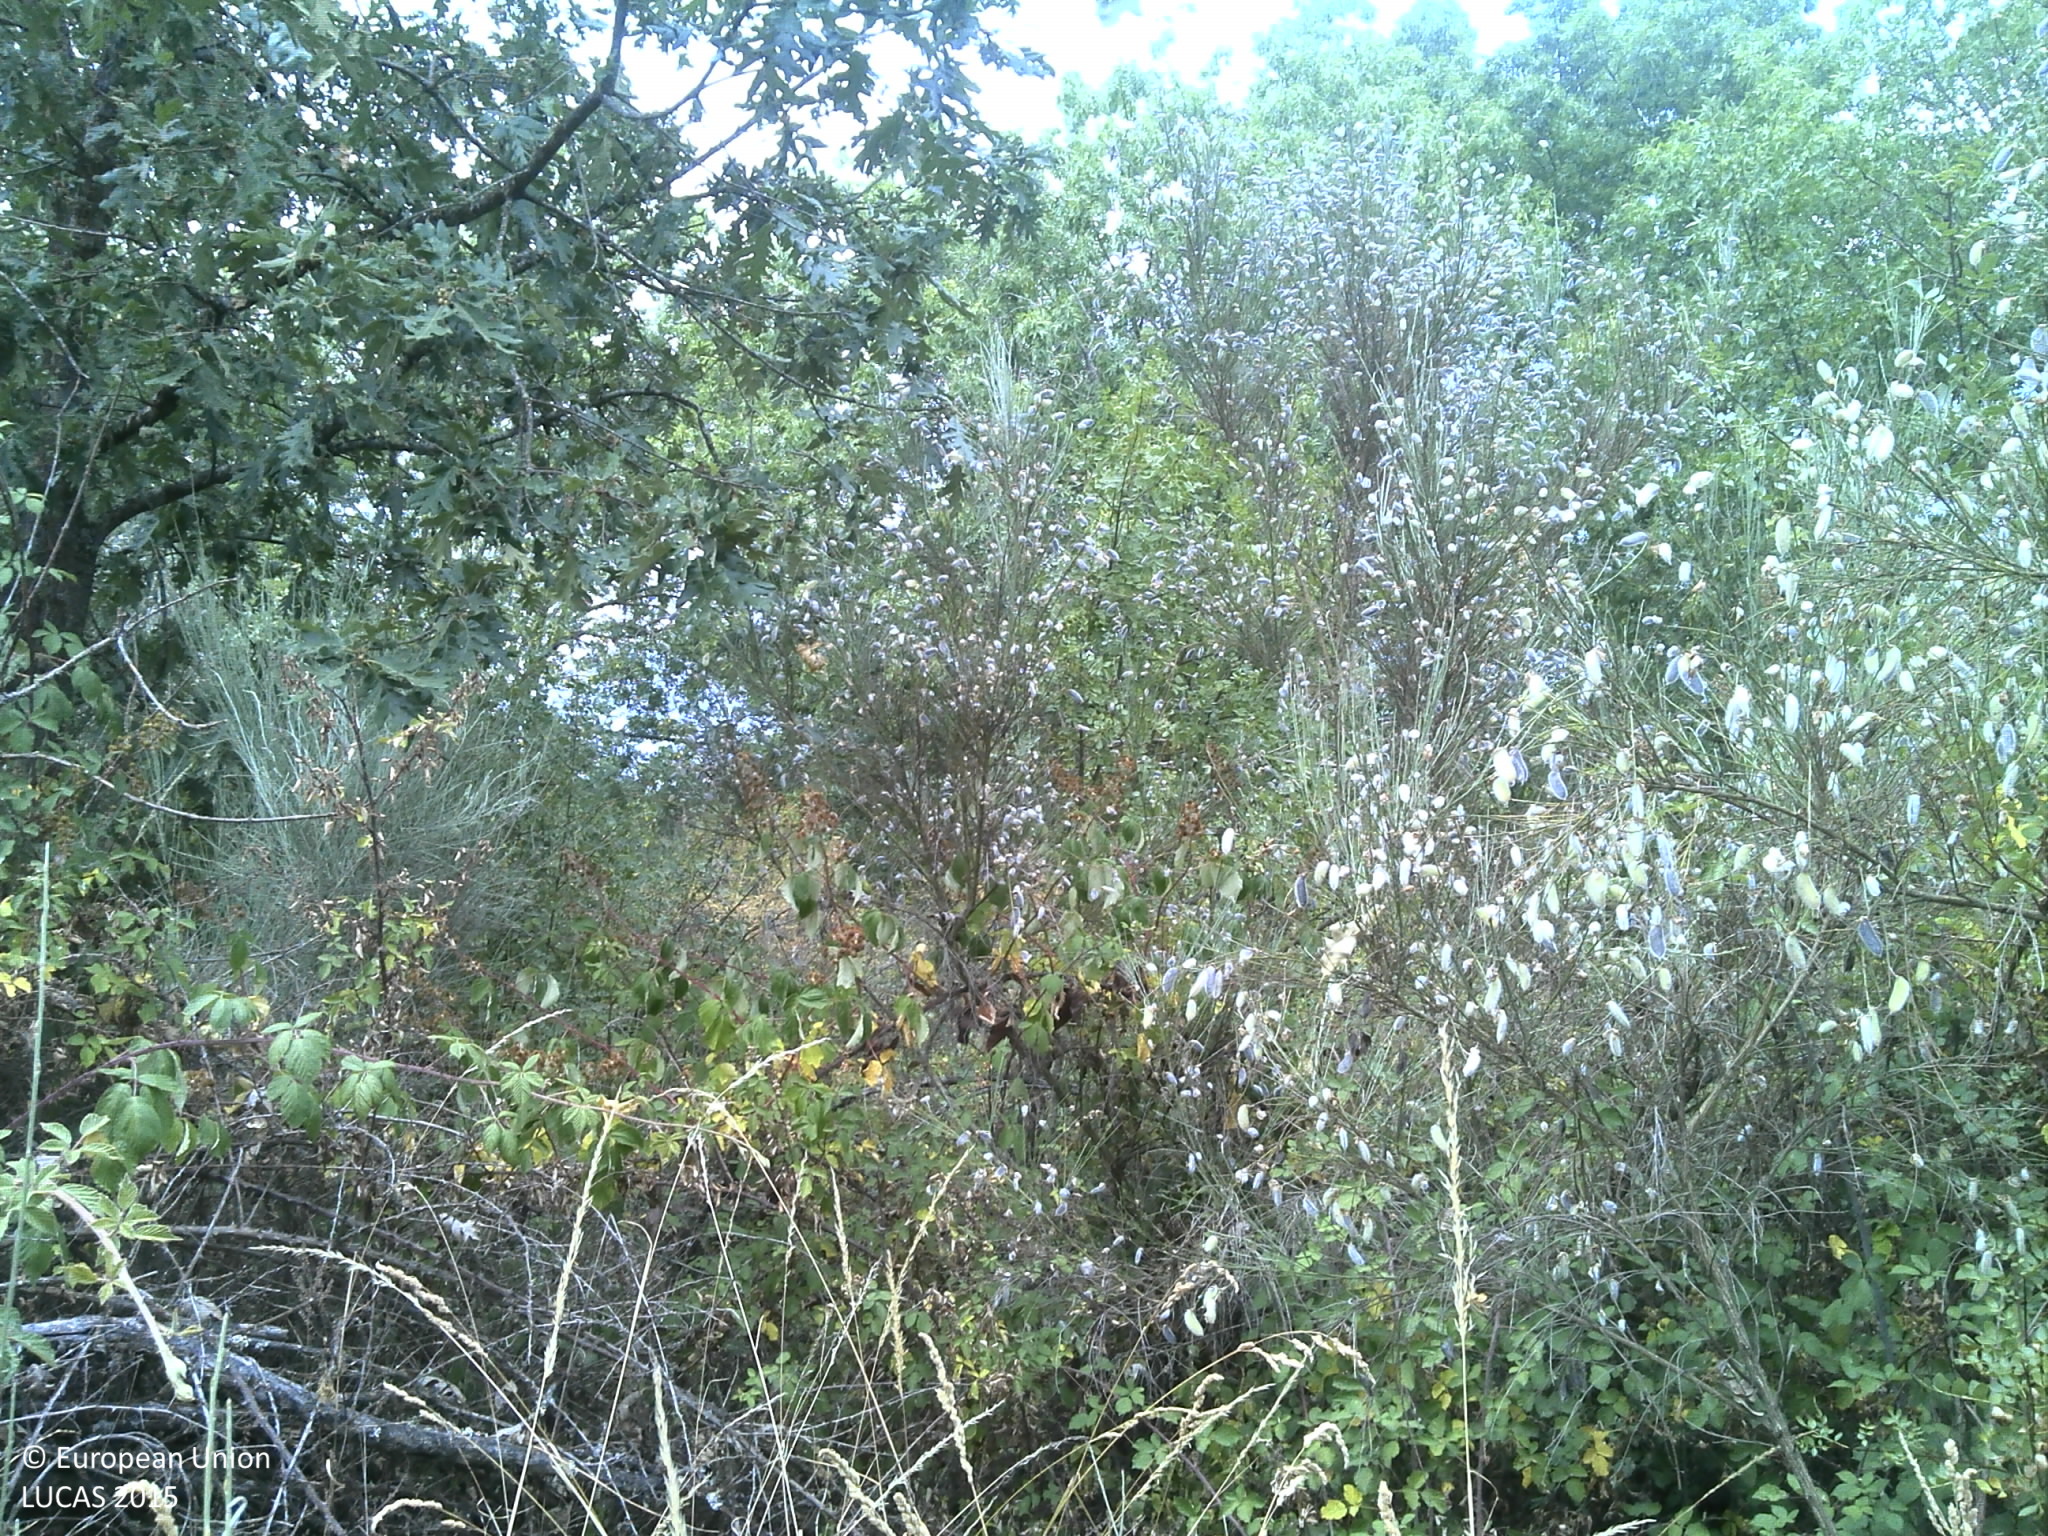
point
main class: Woodland
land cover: Broadleaved woodland
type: mesophytic deciduous forest
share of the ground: 25 - 50 %
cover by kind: shrubs 60 %, broadleaved forest trees 35 %, unconsolidated bare surface 5 %
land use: Semi-natural and natural areas not in use
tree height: > 5 m
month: July
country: PT
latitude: 40.9756
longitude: -7.3591
